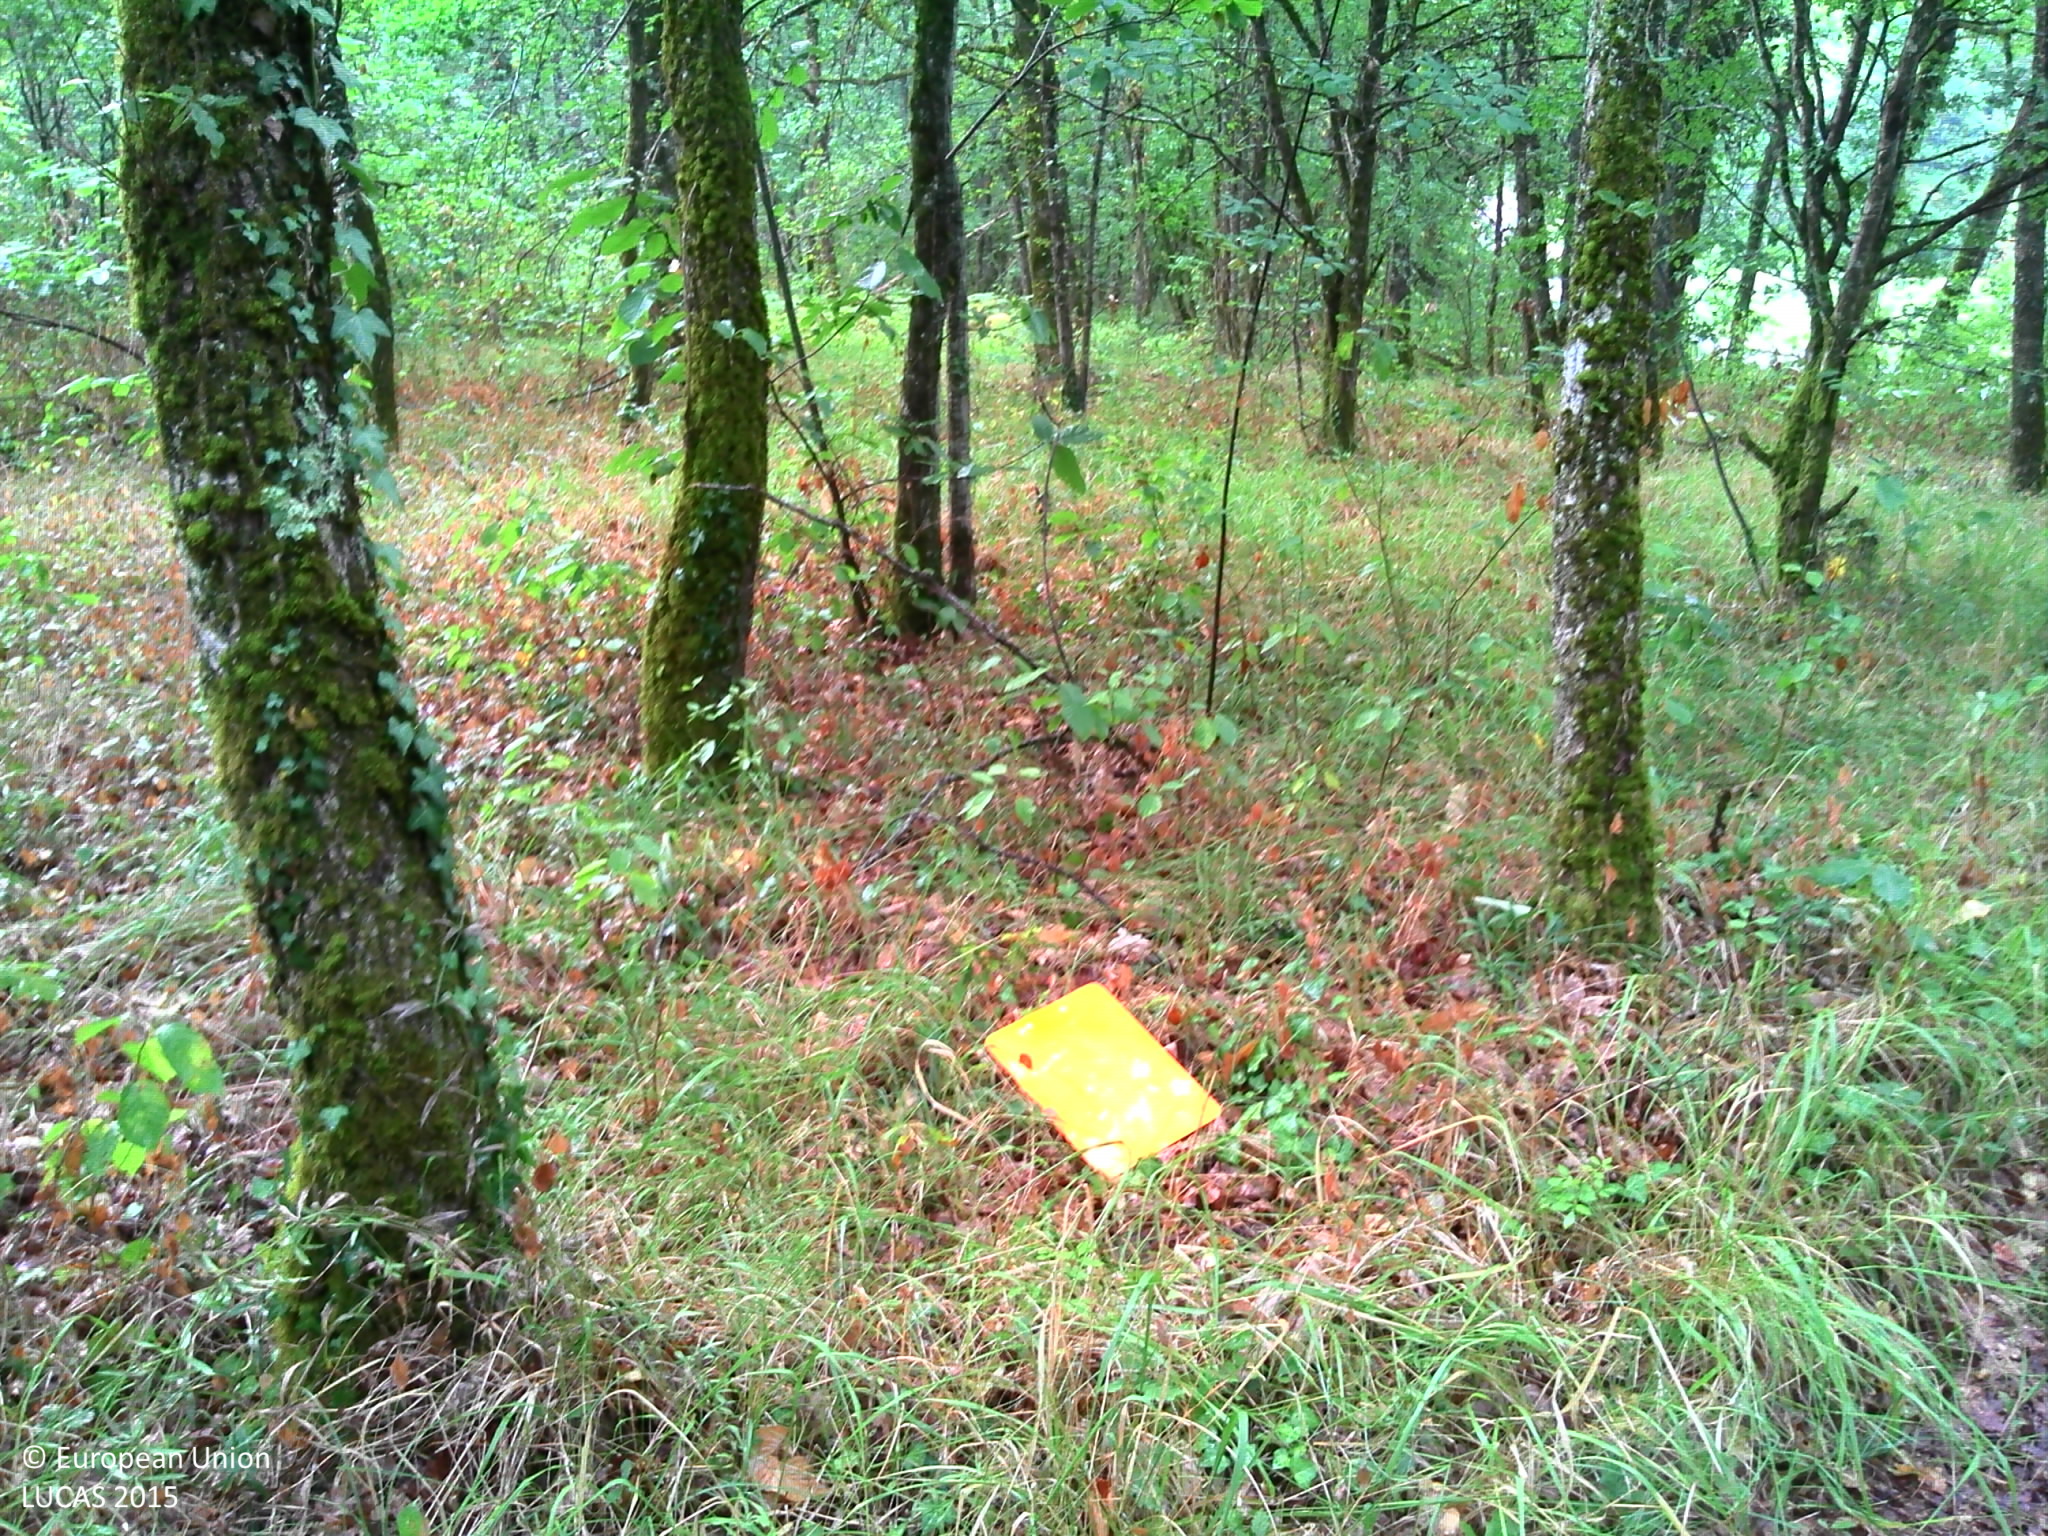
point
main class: Woodland
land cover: Broadleaved woodland
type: thermophilous deciduous forest
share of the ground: > 75 %
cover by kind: broadleaved forest trees 80 %, herbaceous plants 10 %, shrubs 5 %, lichens and mosses 5 %
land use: Forestry
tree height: > 5 m
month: August
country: FR
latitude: 44.6353
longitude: 0.8544
